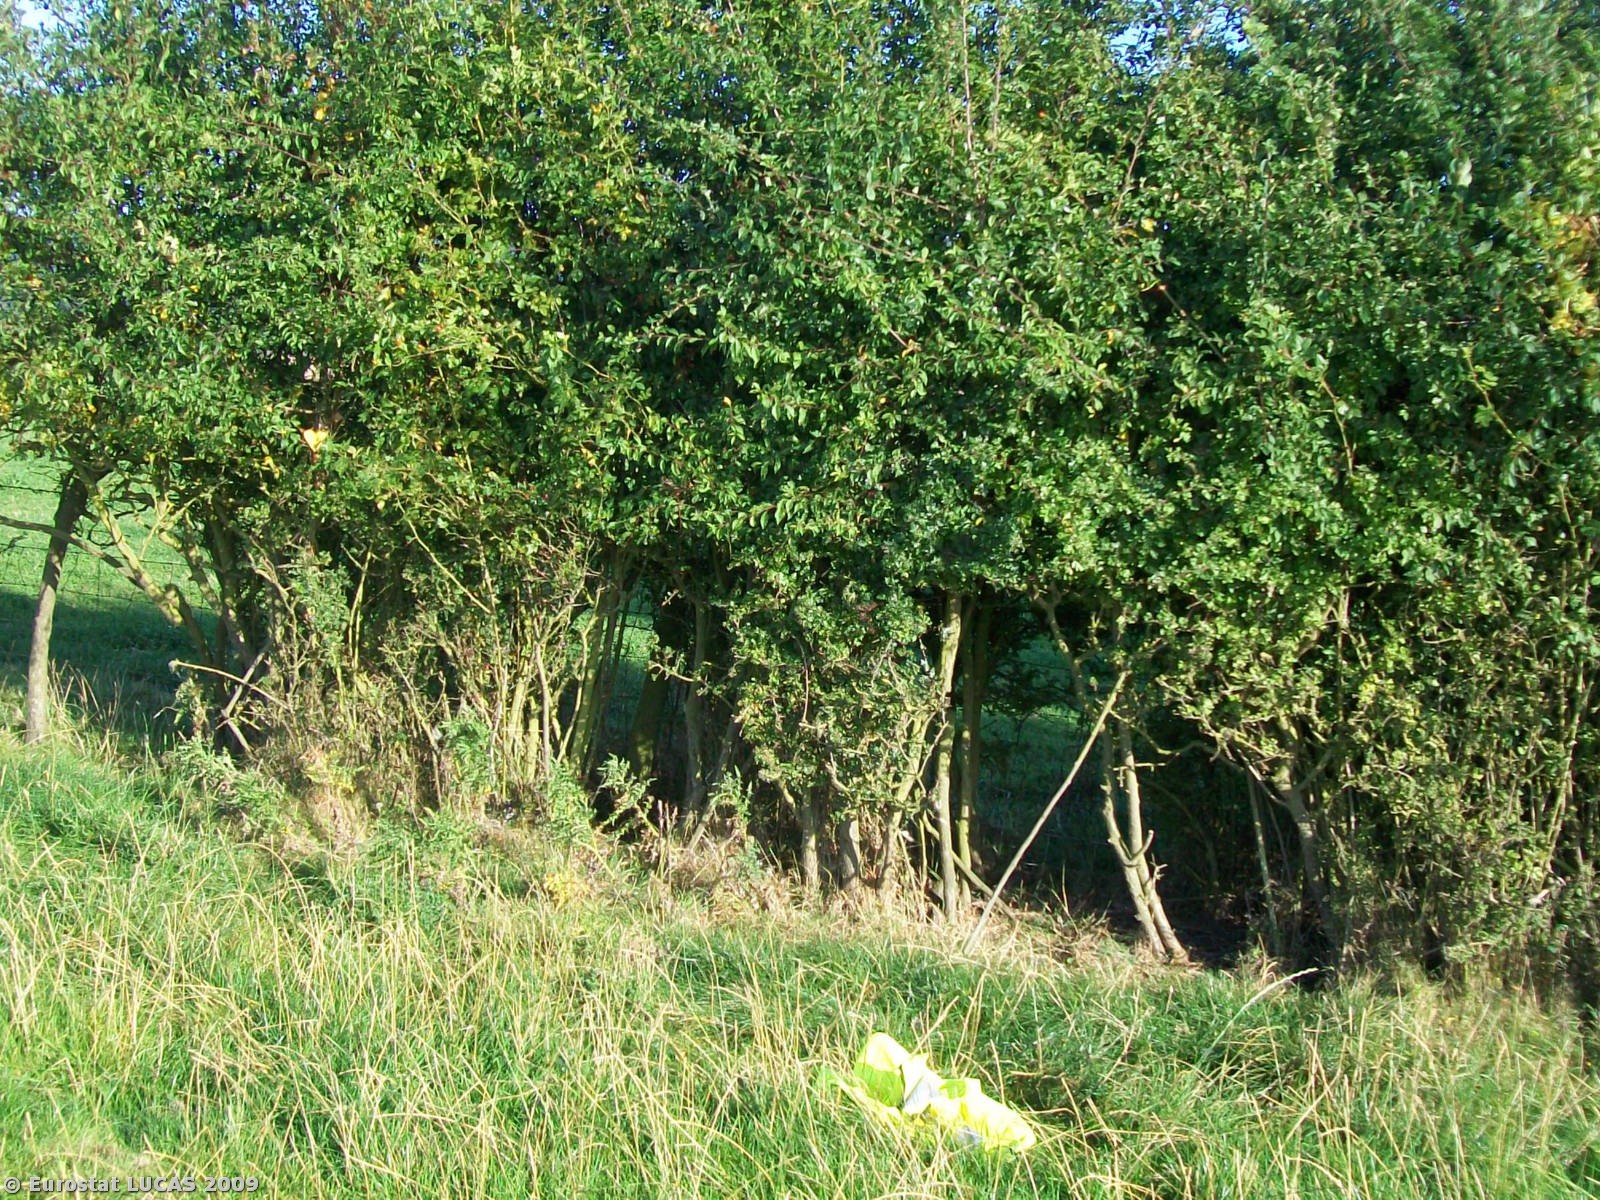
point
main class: Grassland
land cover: Grassland without tree/shrub cover
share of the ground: > 75 %
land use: Agriculture (excluding fallow land and kitchen gardens)
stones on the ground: < 10 %
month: September
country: GB
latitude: 52.5916
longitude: -2.6305
